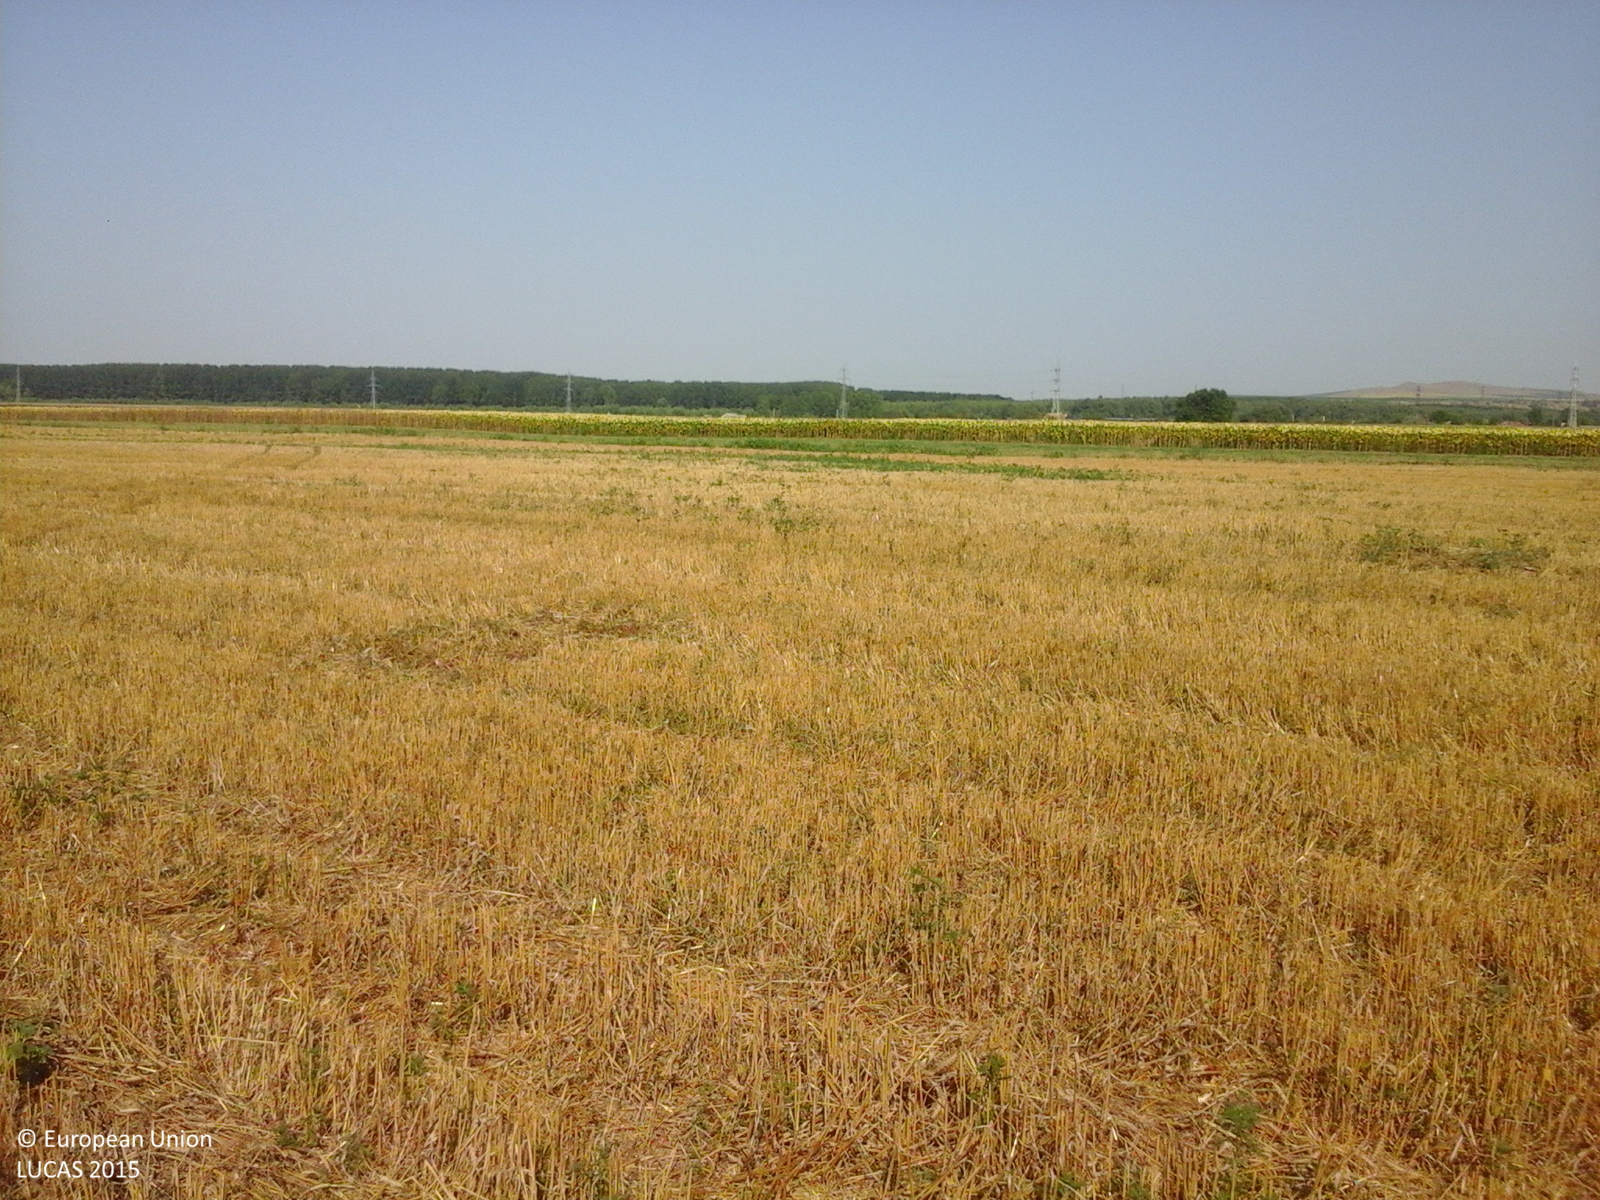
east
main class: Cropland
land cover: Common wheat
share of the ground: 25 - 50 %
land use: Agriculture (excluding fallow land and kitchen gardens)
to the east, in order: Common wheat; Sunflower; Spontaneously vegetated surfaces; Common wheat; Other bare soil
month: August
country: RO
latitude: 44.8991
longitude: 28.1103
